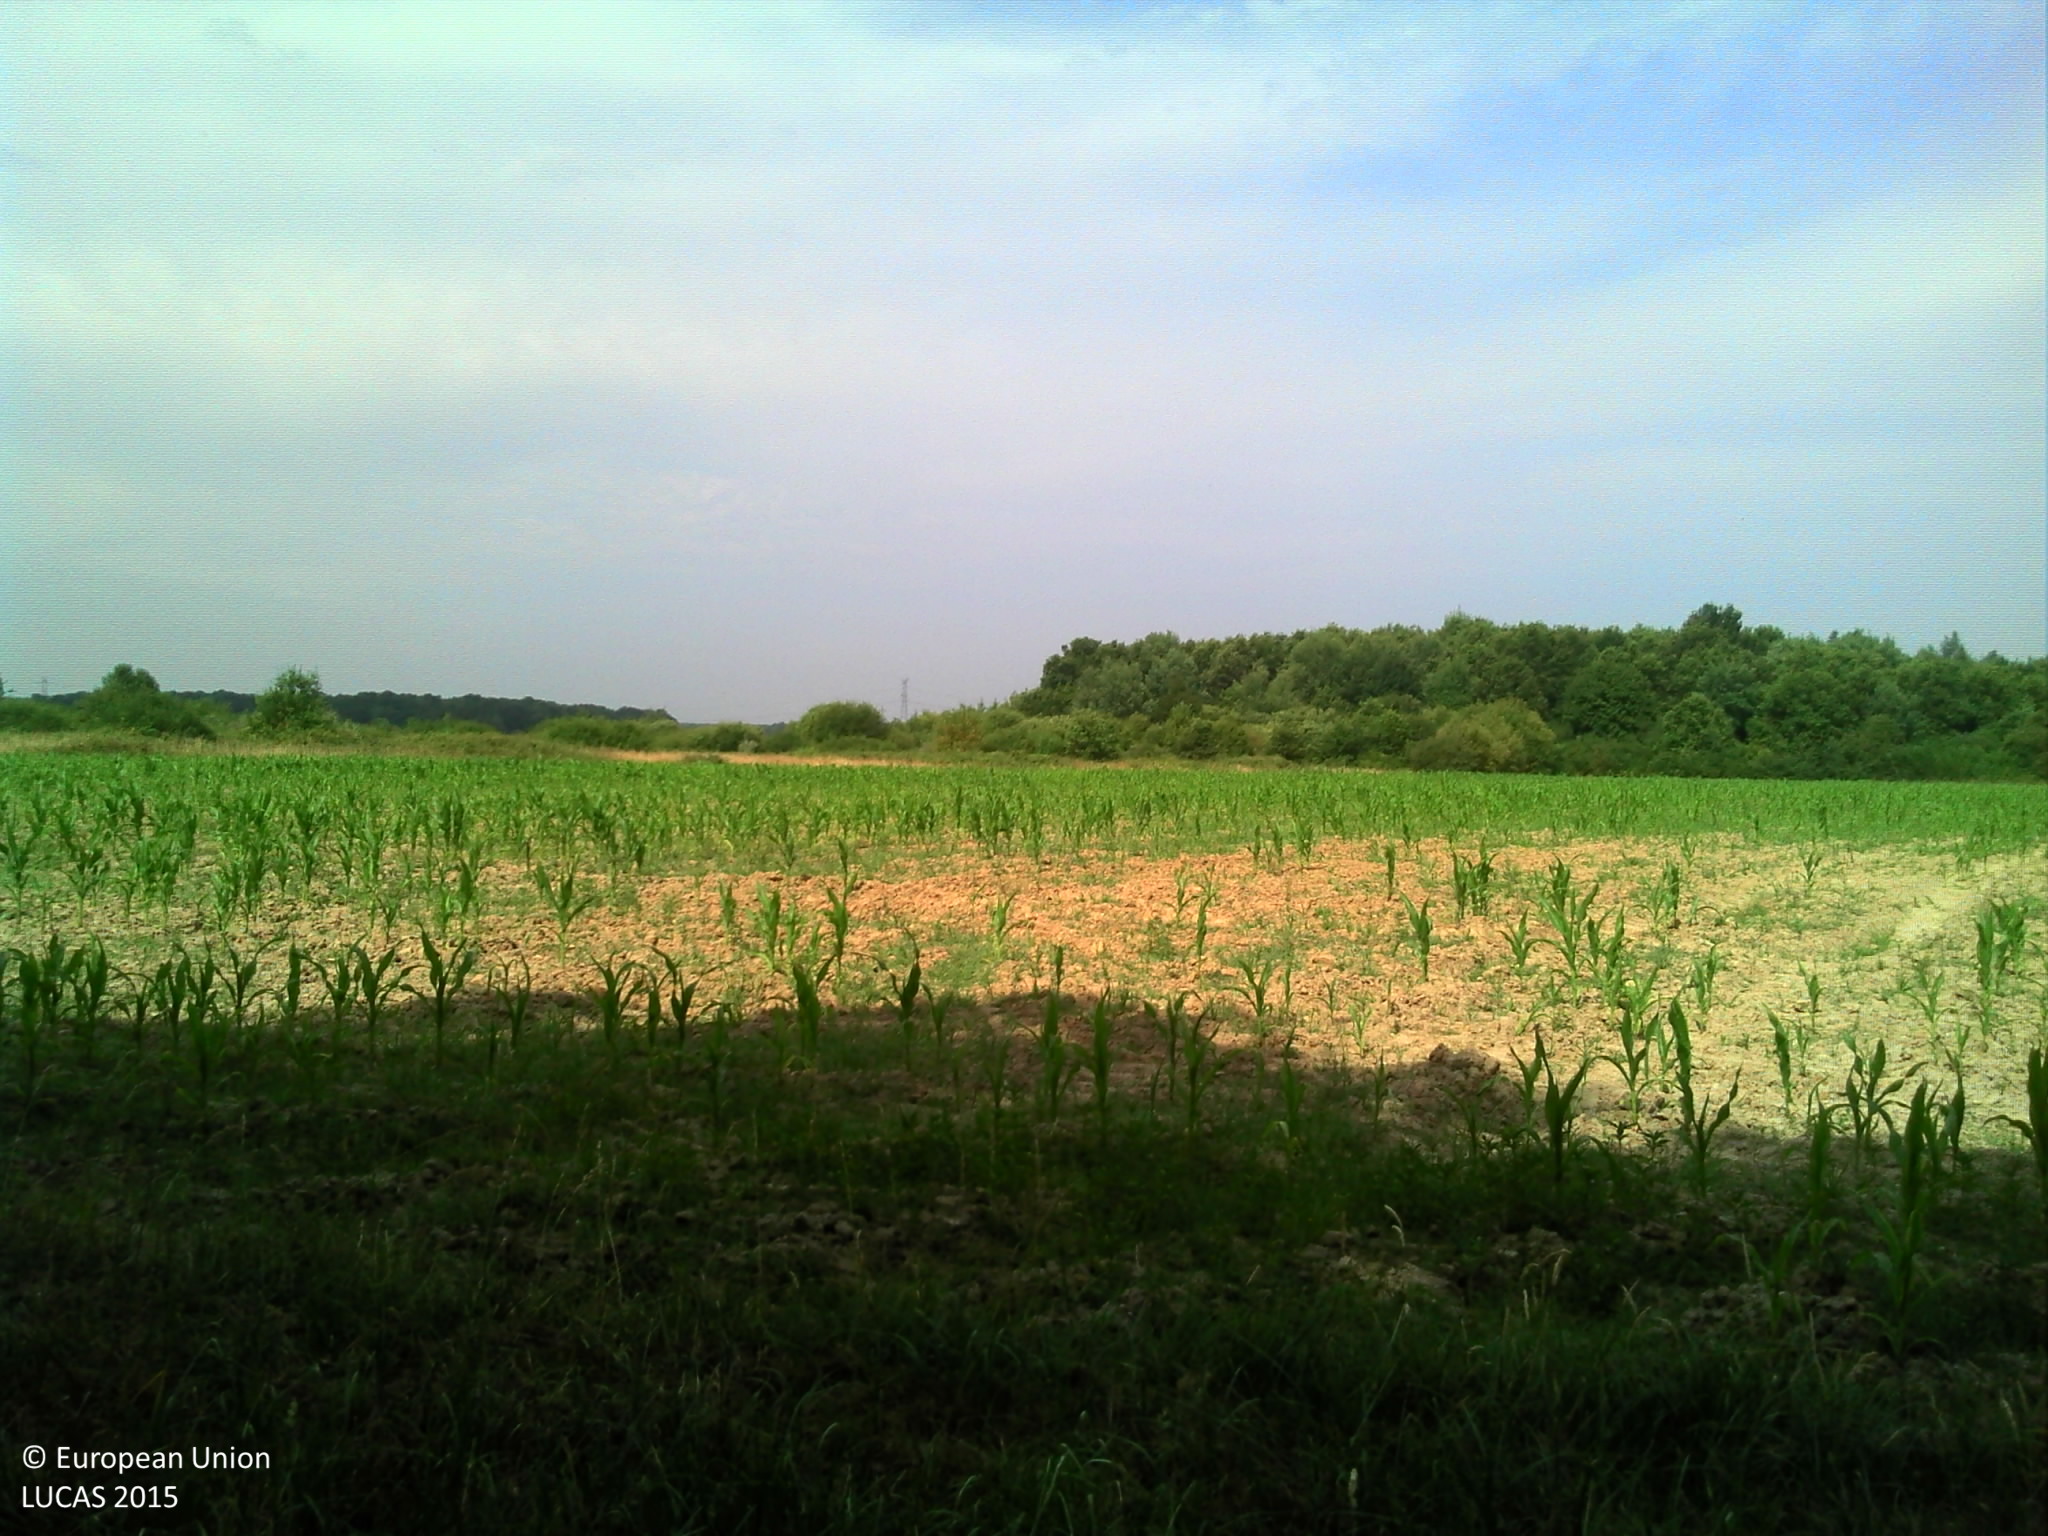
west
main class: Woodland
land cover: Broadleaved woodland
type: mesophytic deciduous forest
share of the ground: > 75 %
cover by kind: broadleaved forest trees 100 %
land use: Agriculture (excluding fallow land and kitchen gardens)
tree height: > 5 m
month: July
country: FR
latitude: 47.7354
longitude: 2.8053
